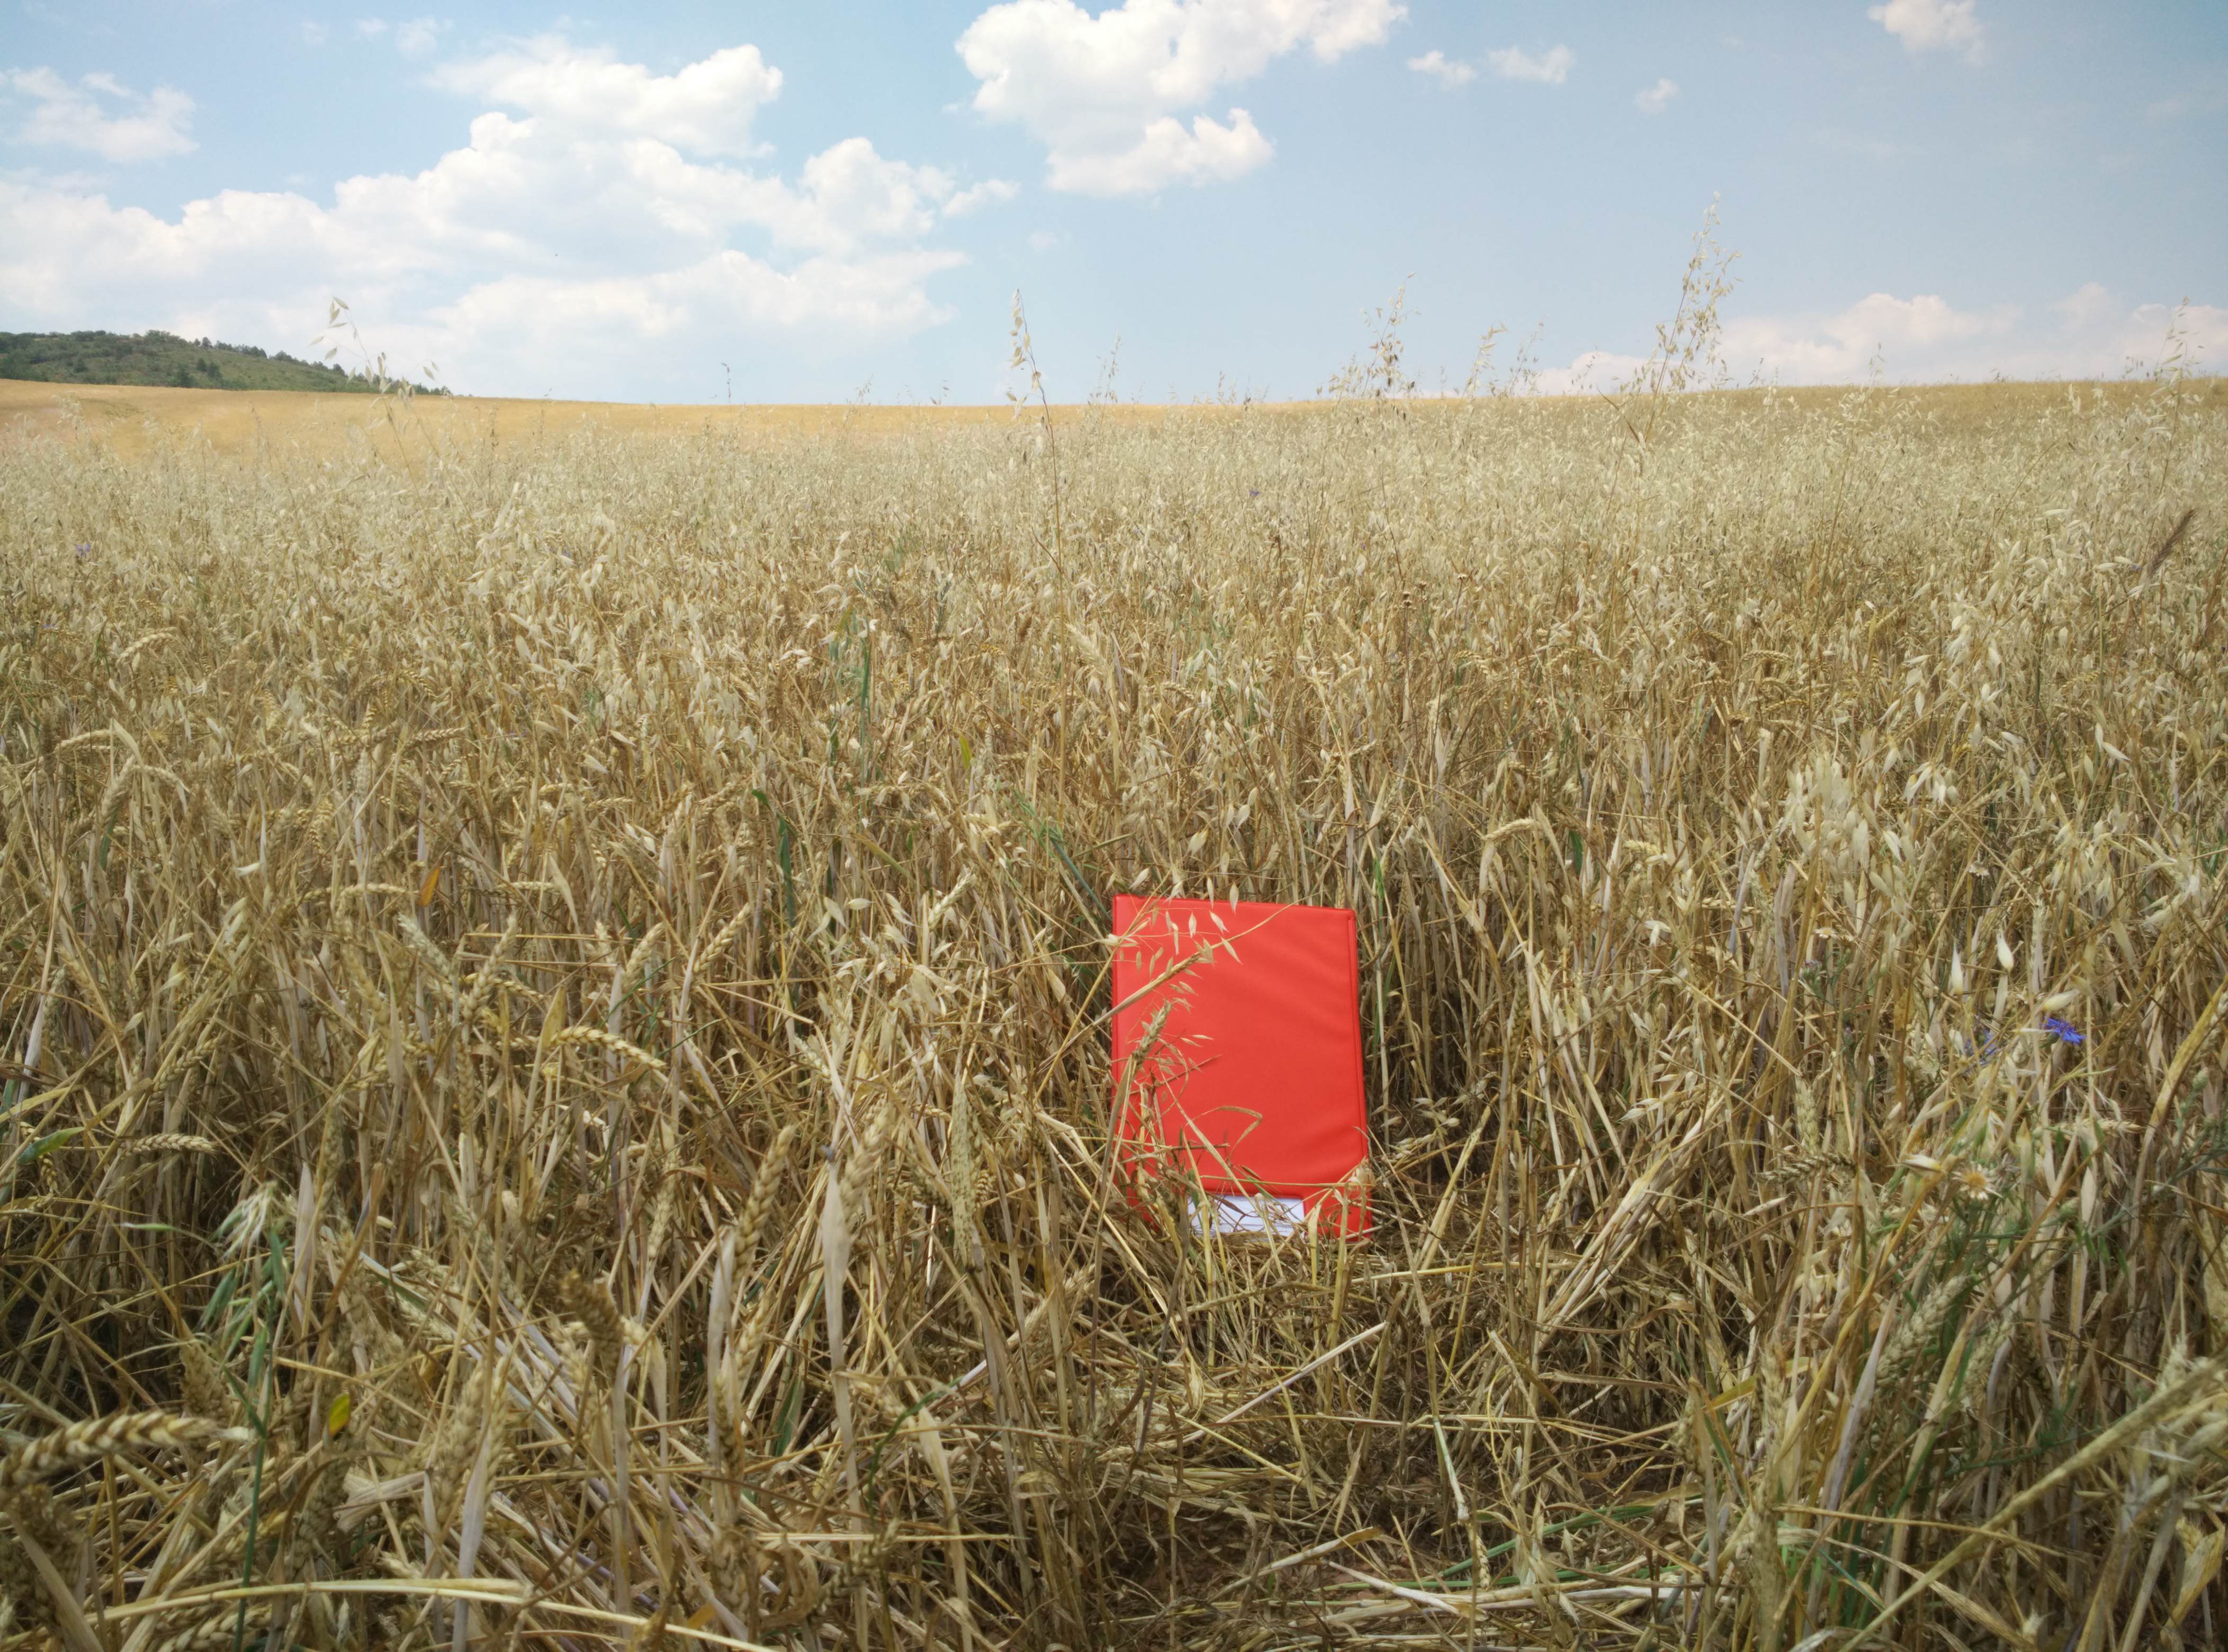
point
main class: Cropland
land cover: Mixed cereals for fodder
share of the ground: > 75 %
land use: Agriculture (excluding fallow land and kitchen gardens)
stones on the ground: 25 - 50 %
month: June
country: ES
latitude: 40.8941
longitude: -1.8803
